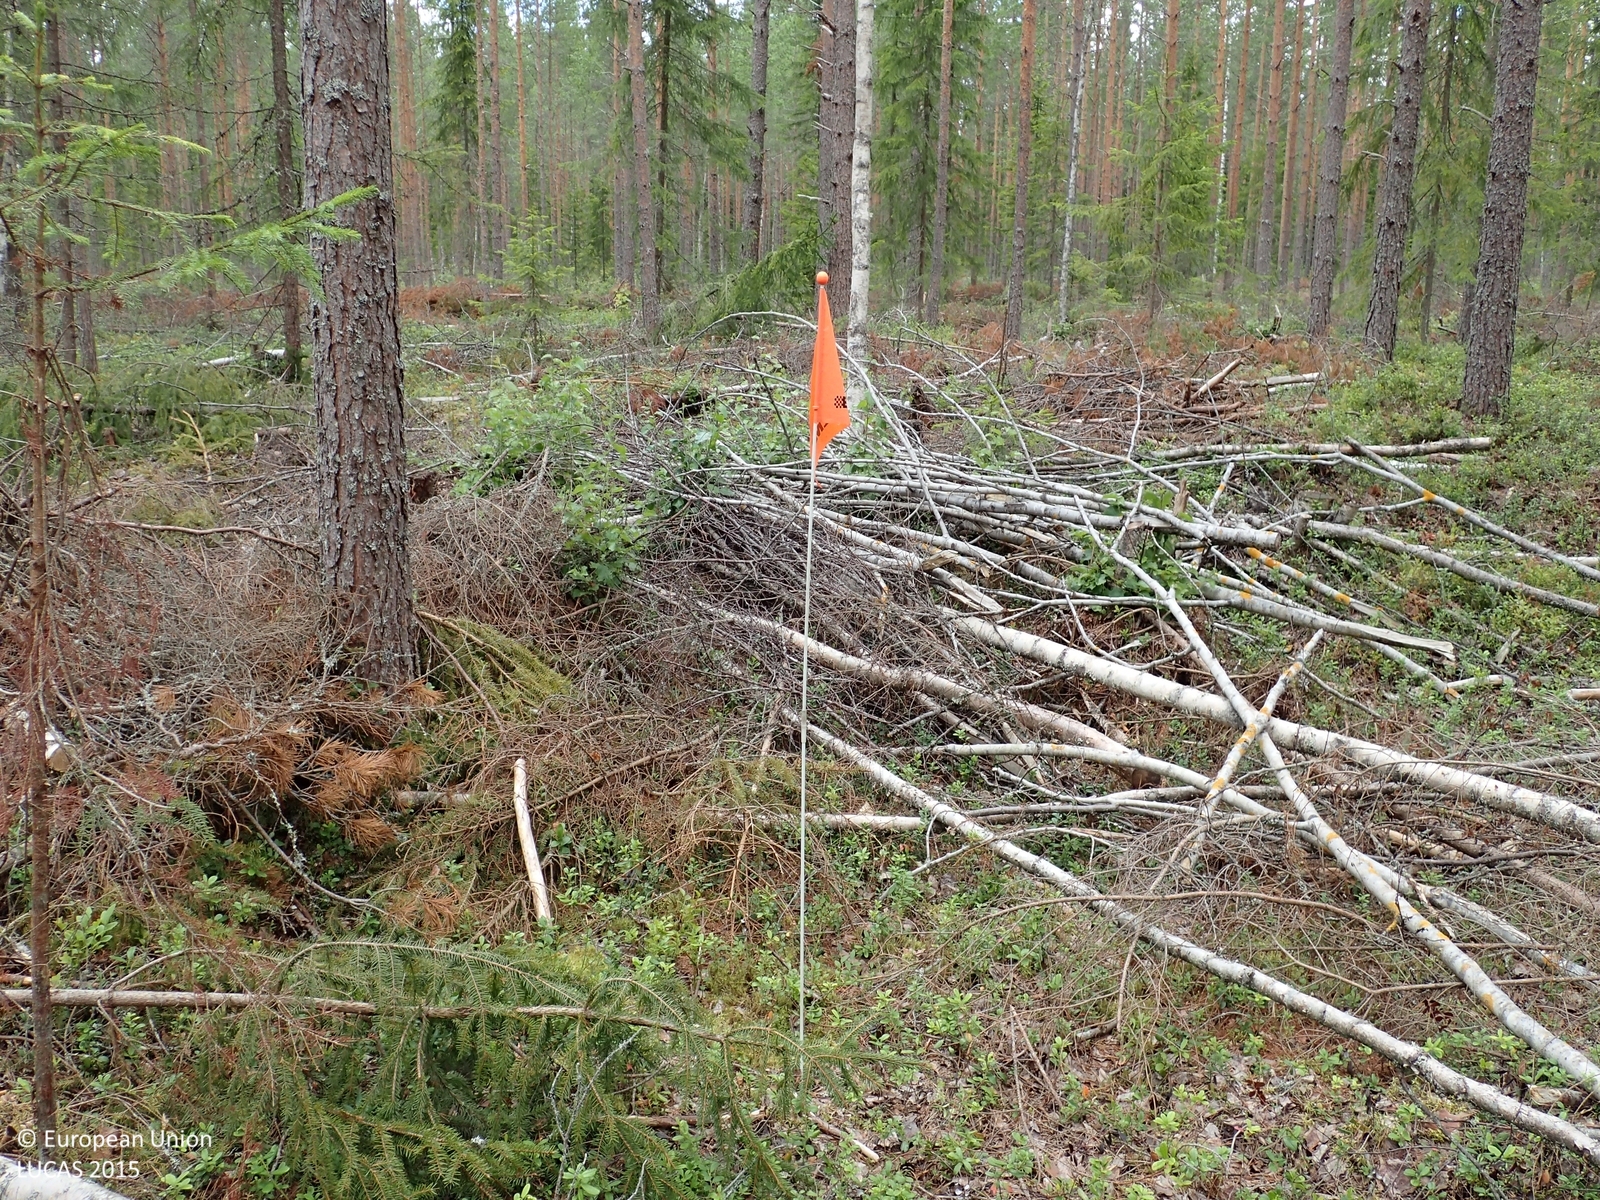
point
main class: Woodland
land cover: Pine dominated coniferous woodland
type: boreal forest
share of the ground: 25 - 50 %
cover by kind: coniferous forest trees 40 %, shrubs 40 %, lichens and mosses 5 %
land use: Forestry
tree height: > 5 m
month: August
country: FI
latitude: 62.6779
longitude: 21.7821
